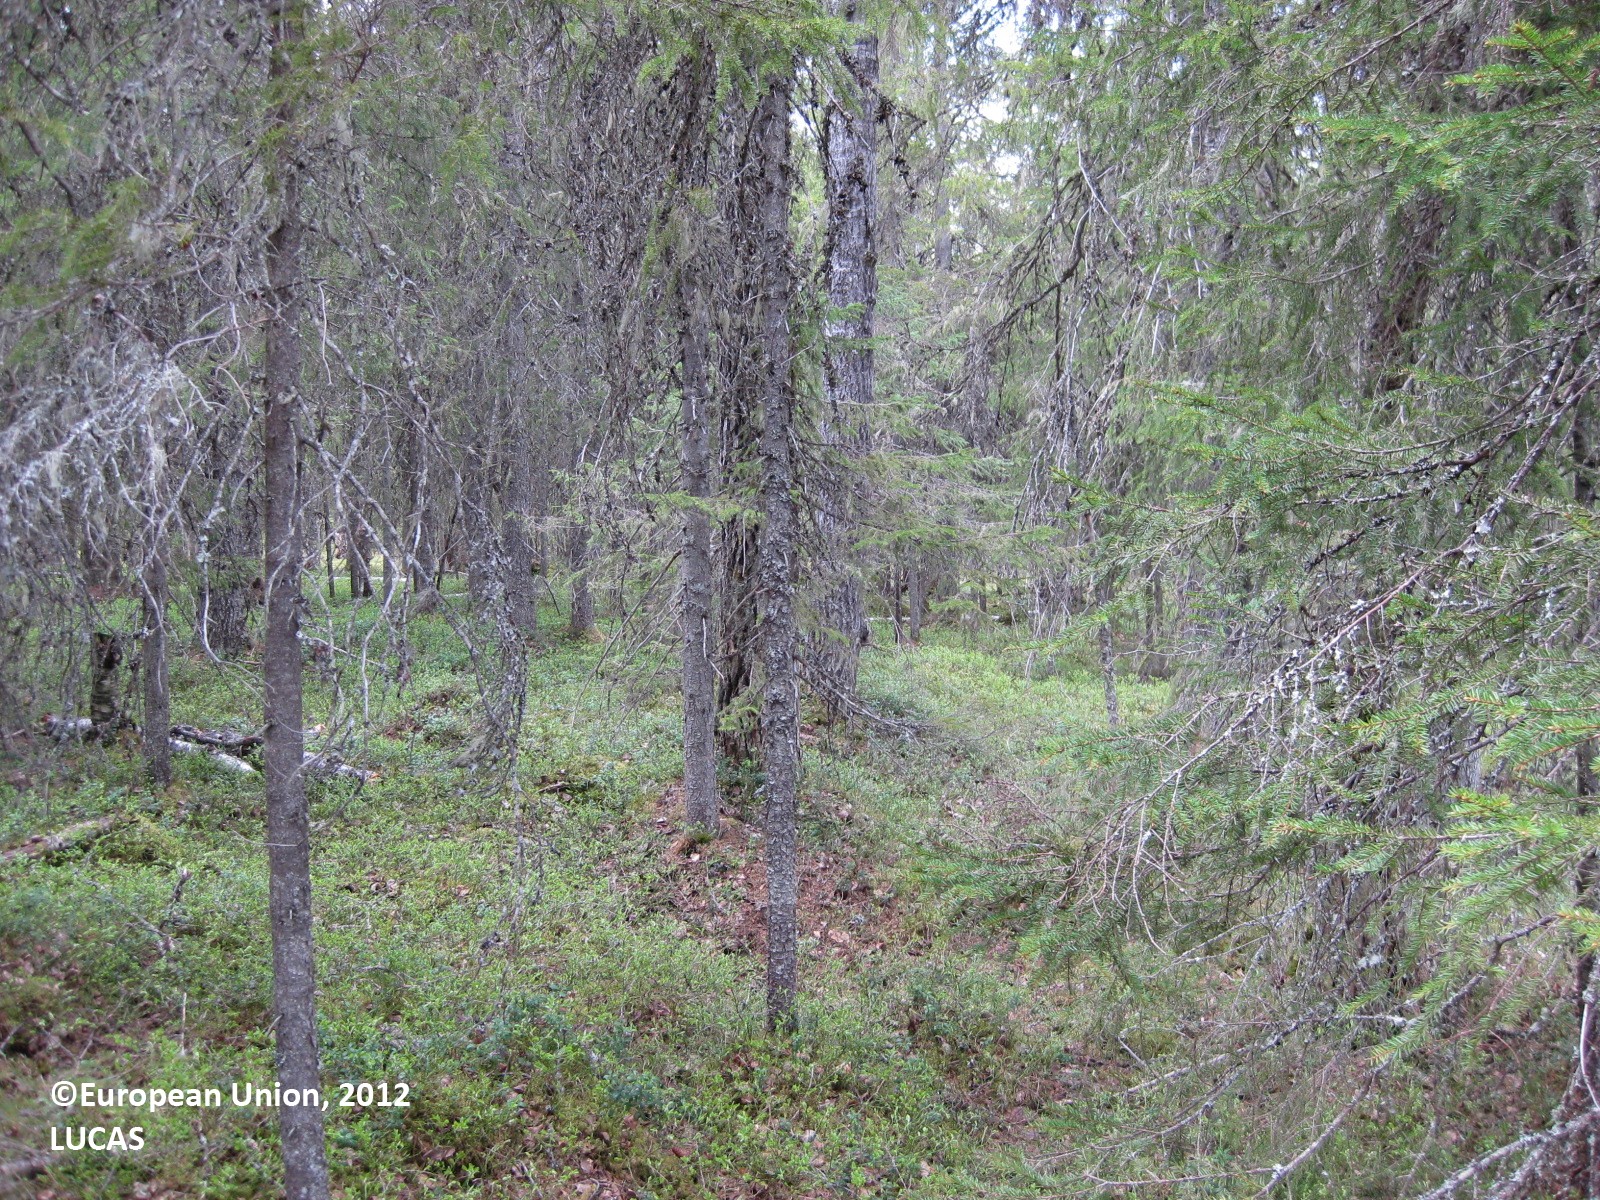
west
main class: Woodland
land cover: Spruce dominated coniferous woodland
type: boreal forest
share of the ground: > 75 %
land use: Forestry
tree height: > 5 m
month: June
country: FI
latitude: 65.3253
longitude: 29.1882
